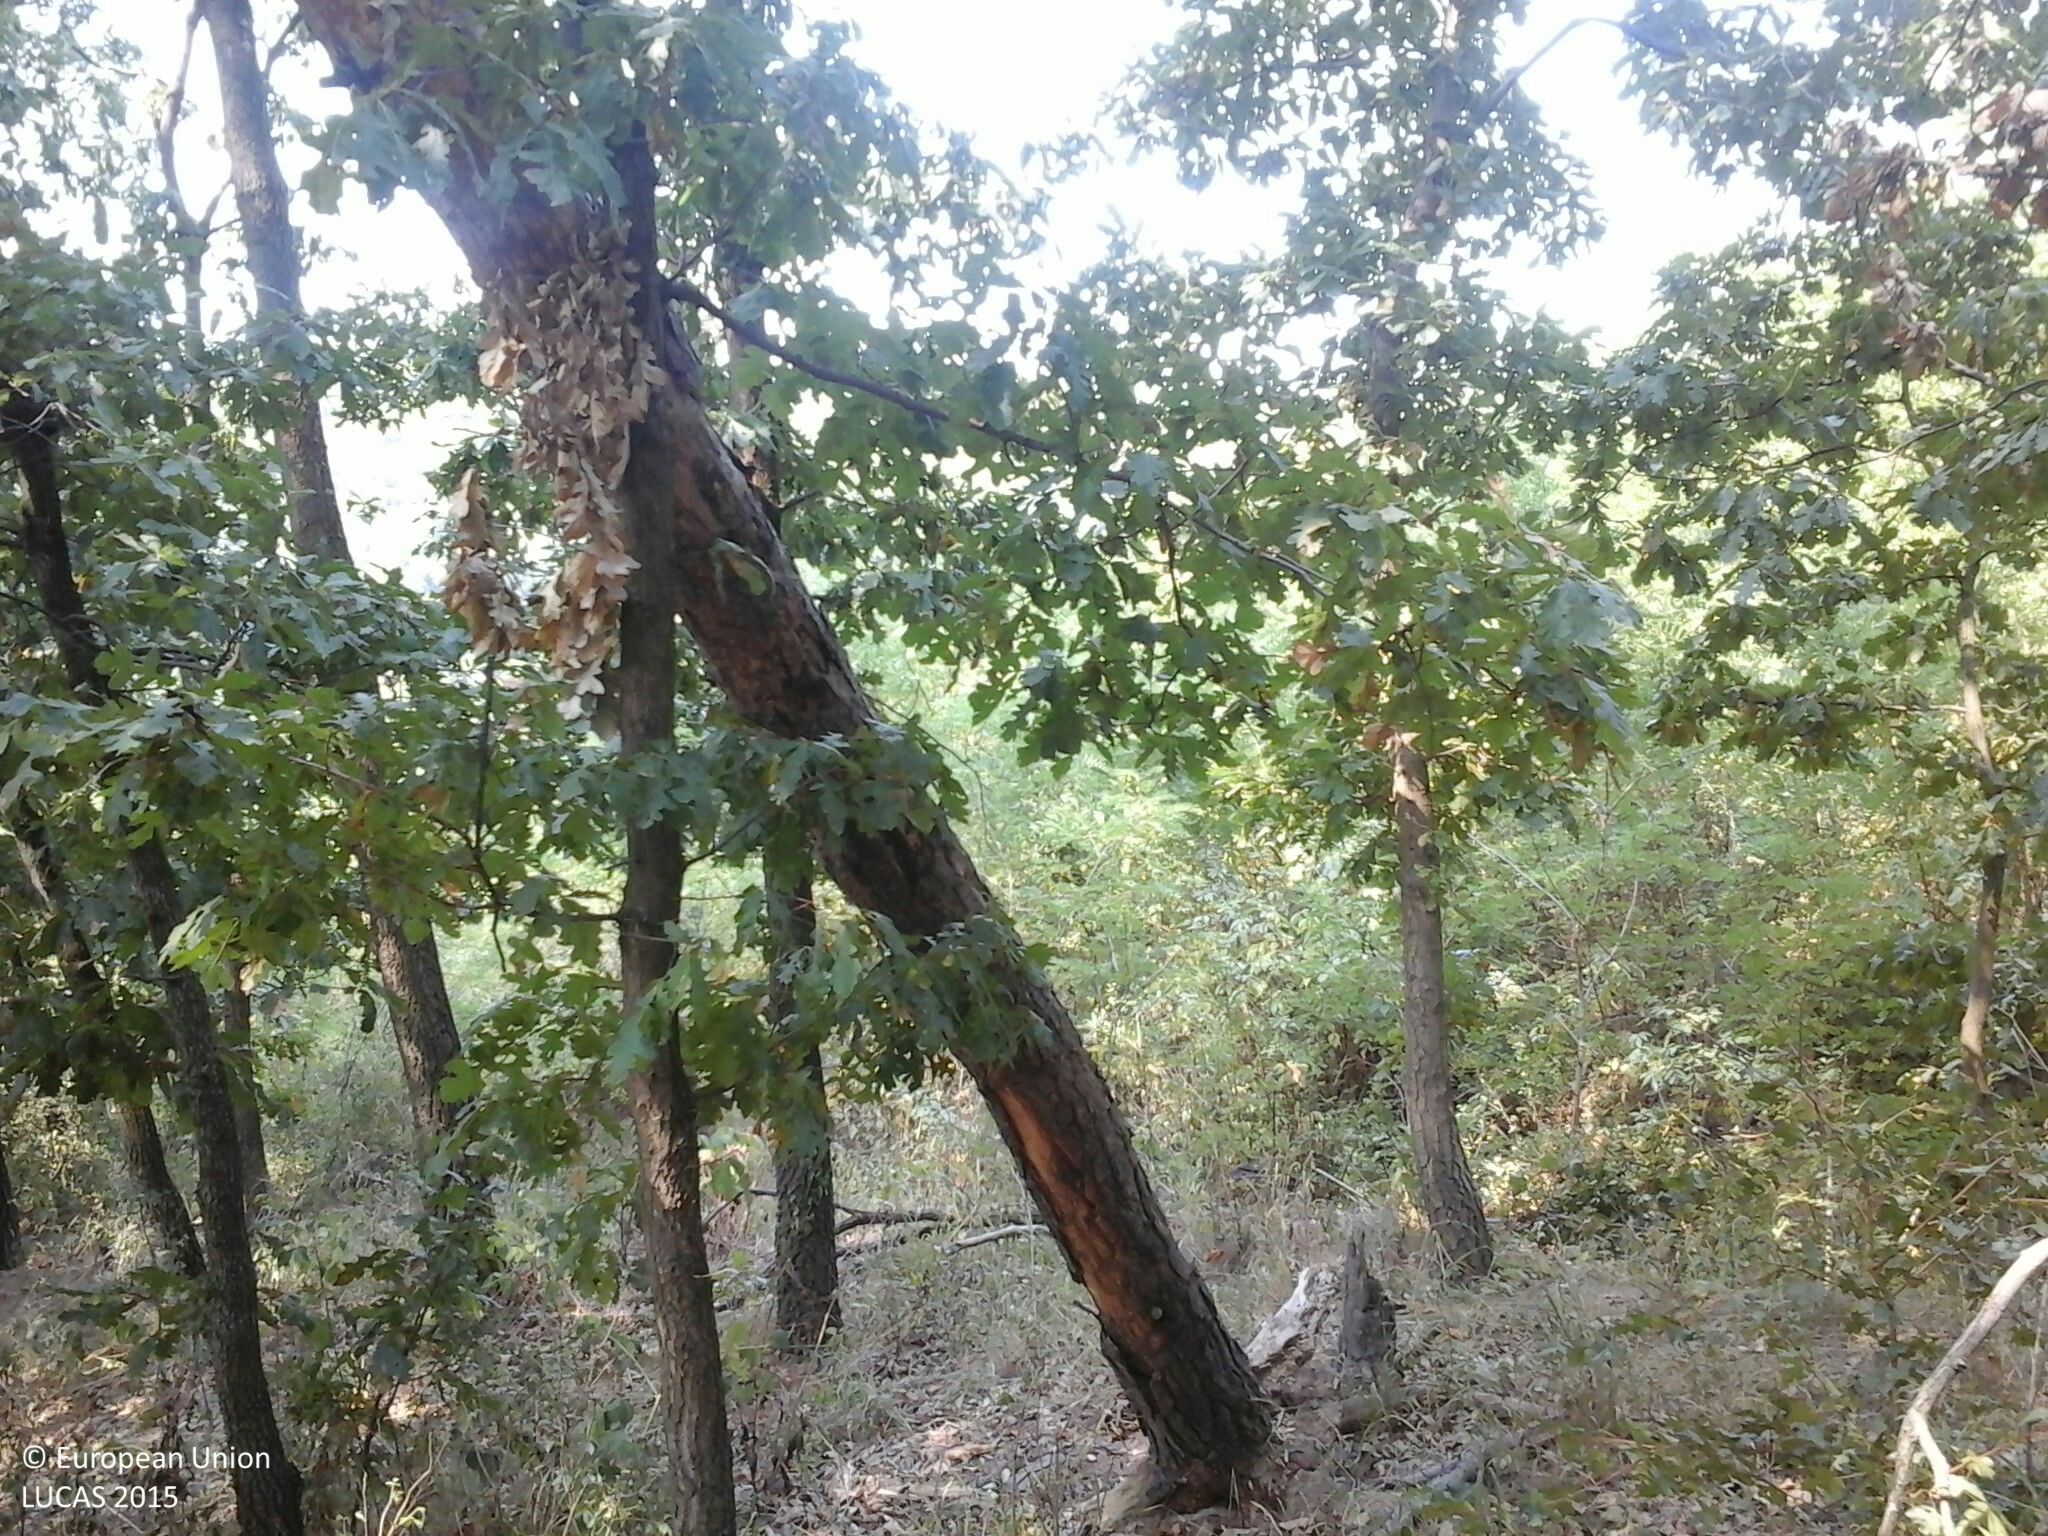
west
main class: Woodland
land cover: Broadleaved woodland
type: thermophilous deciduous forest
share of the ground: > 75 %
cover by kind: broadleaved forest trees 80 %, shrubs 15 %, herbaceous plants 5 %
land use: Forestry
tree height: > 5 m
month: August
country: HU
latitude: 47.9118
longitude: 19.1855
